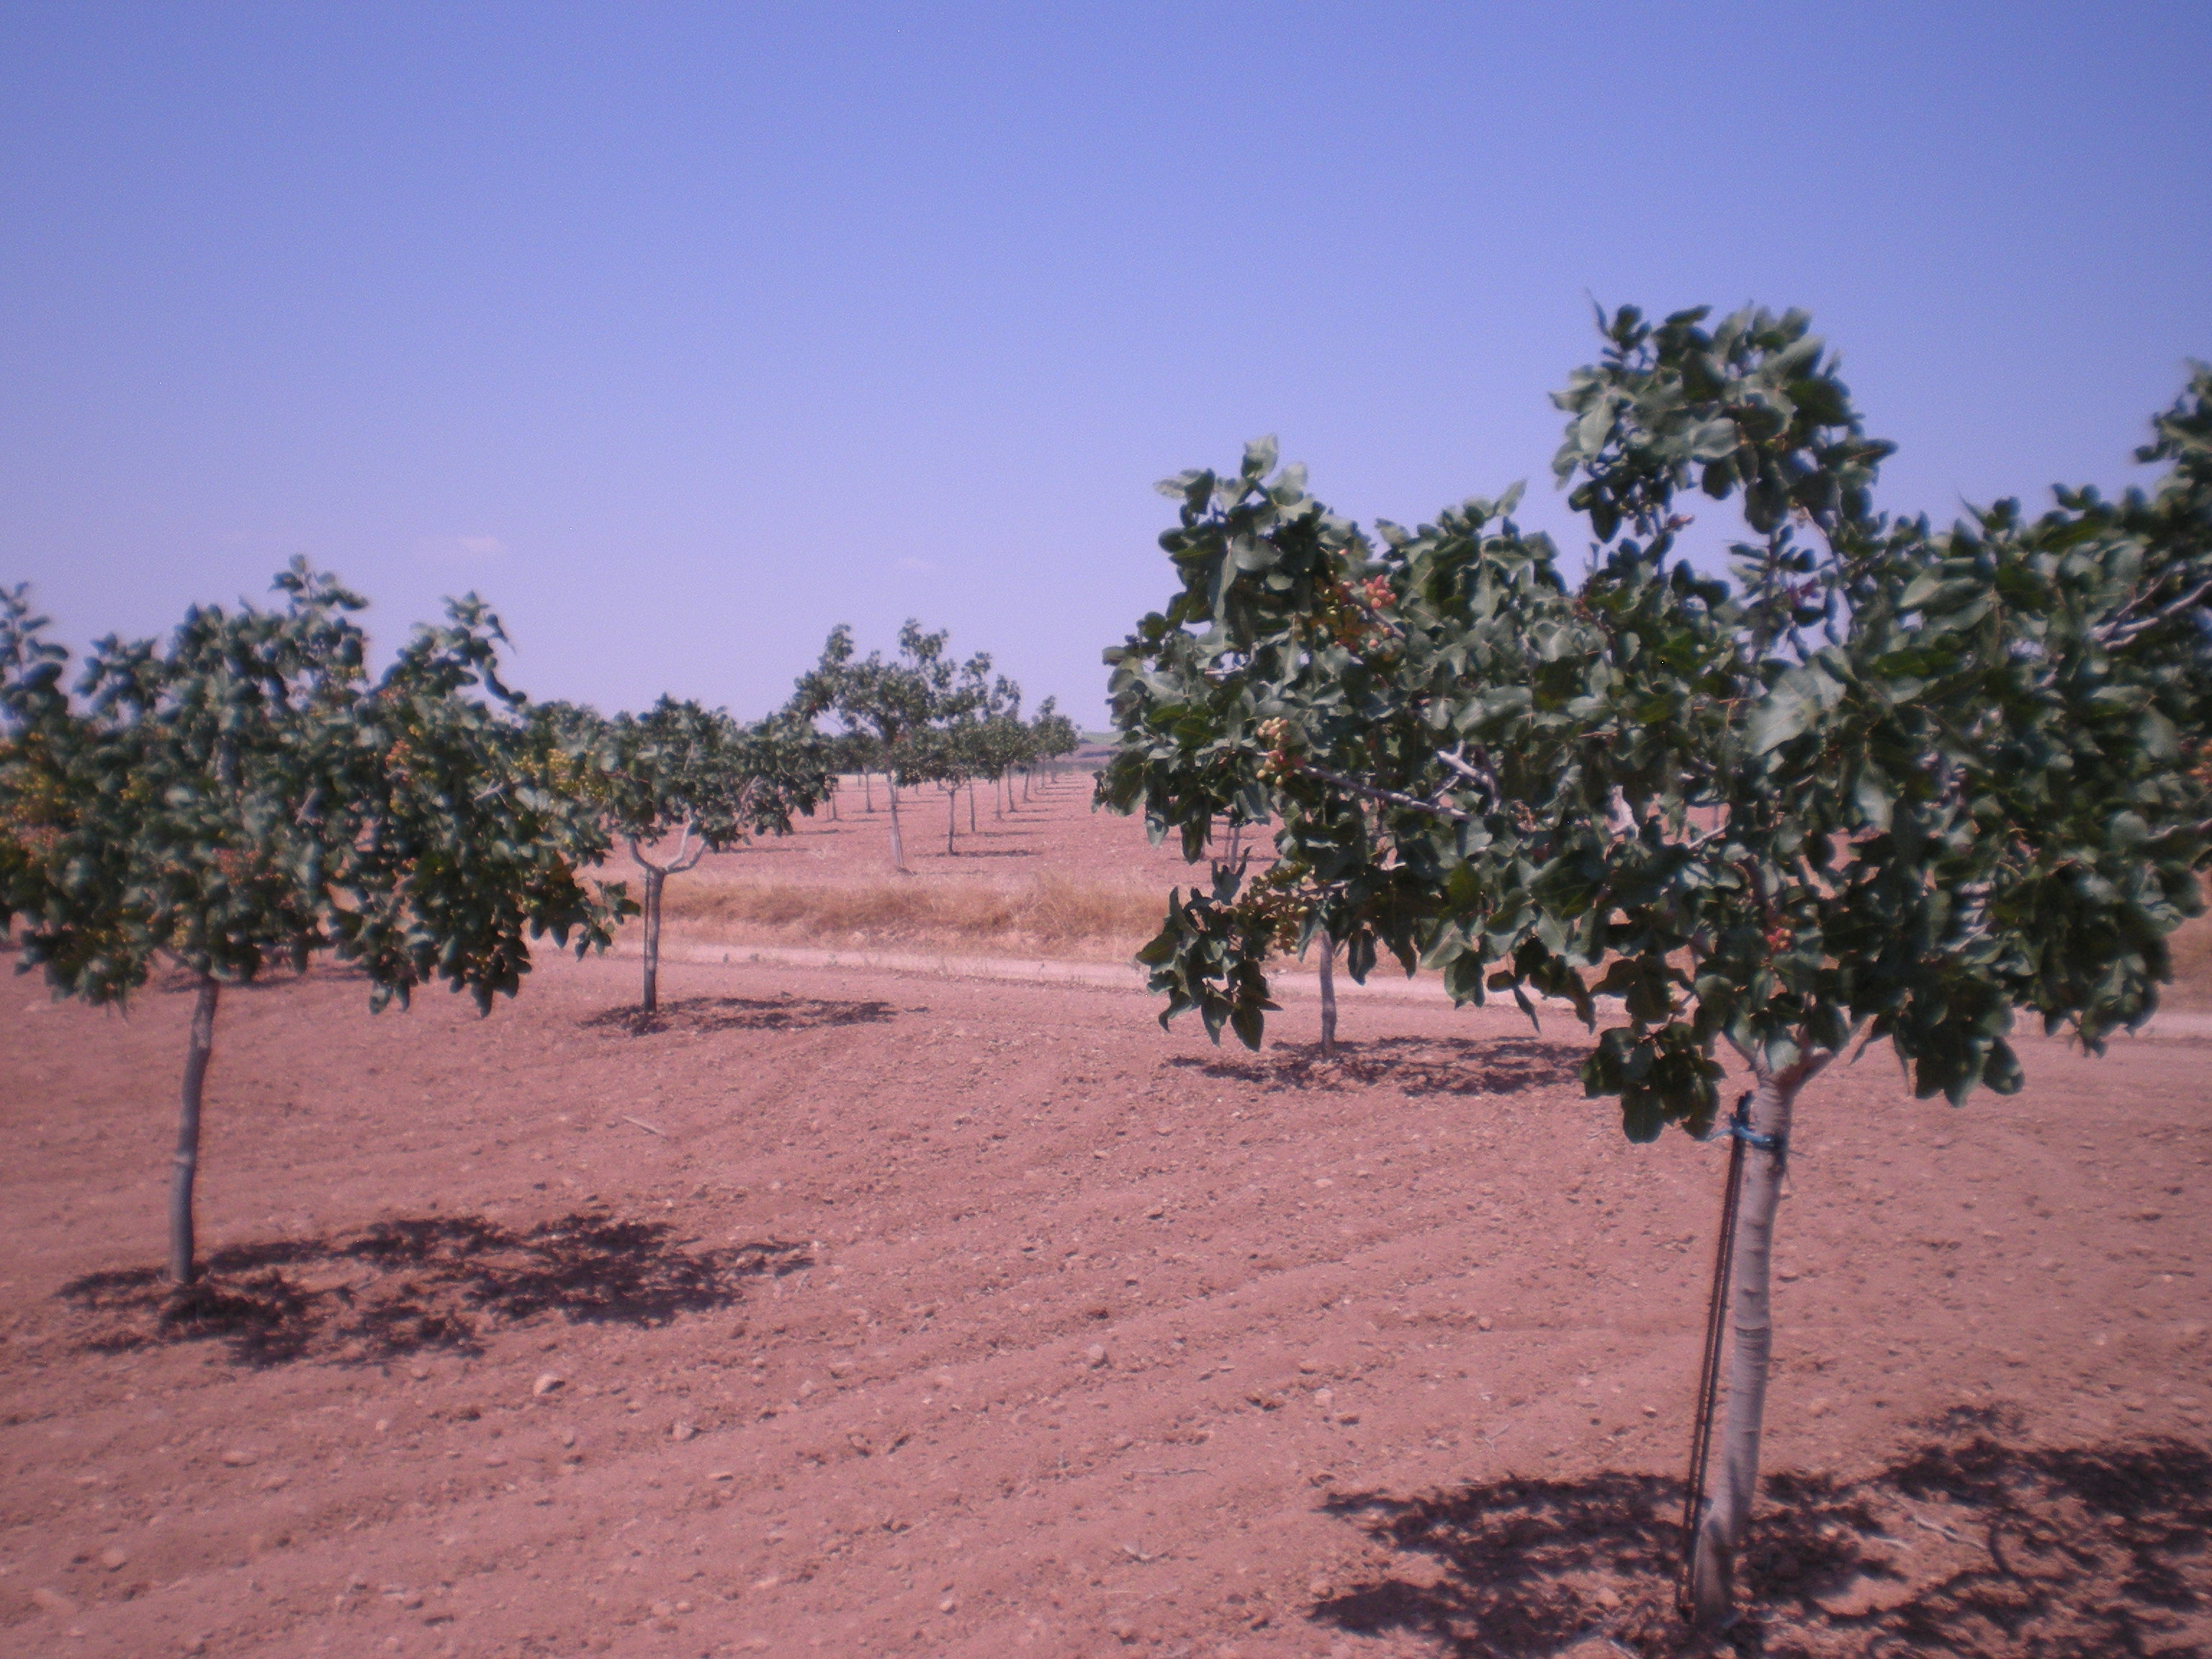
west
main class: Cropland
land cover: Nuts trees
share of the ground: < 10 %
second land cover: Other bare soil
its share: > 75 %
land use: Agriculture (excluding fallow land and kitchen gardens)
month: June
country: ES
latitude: 39.5816
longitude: -3.3999
